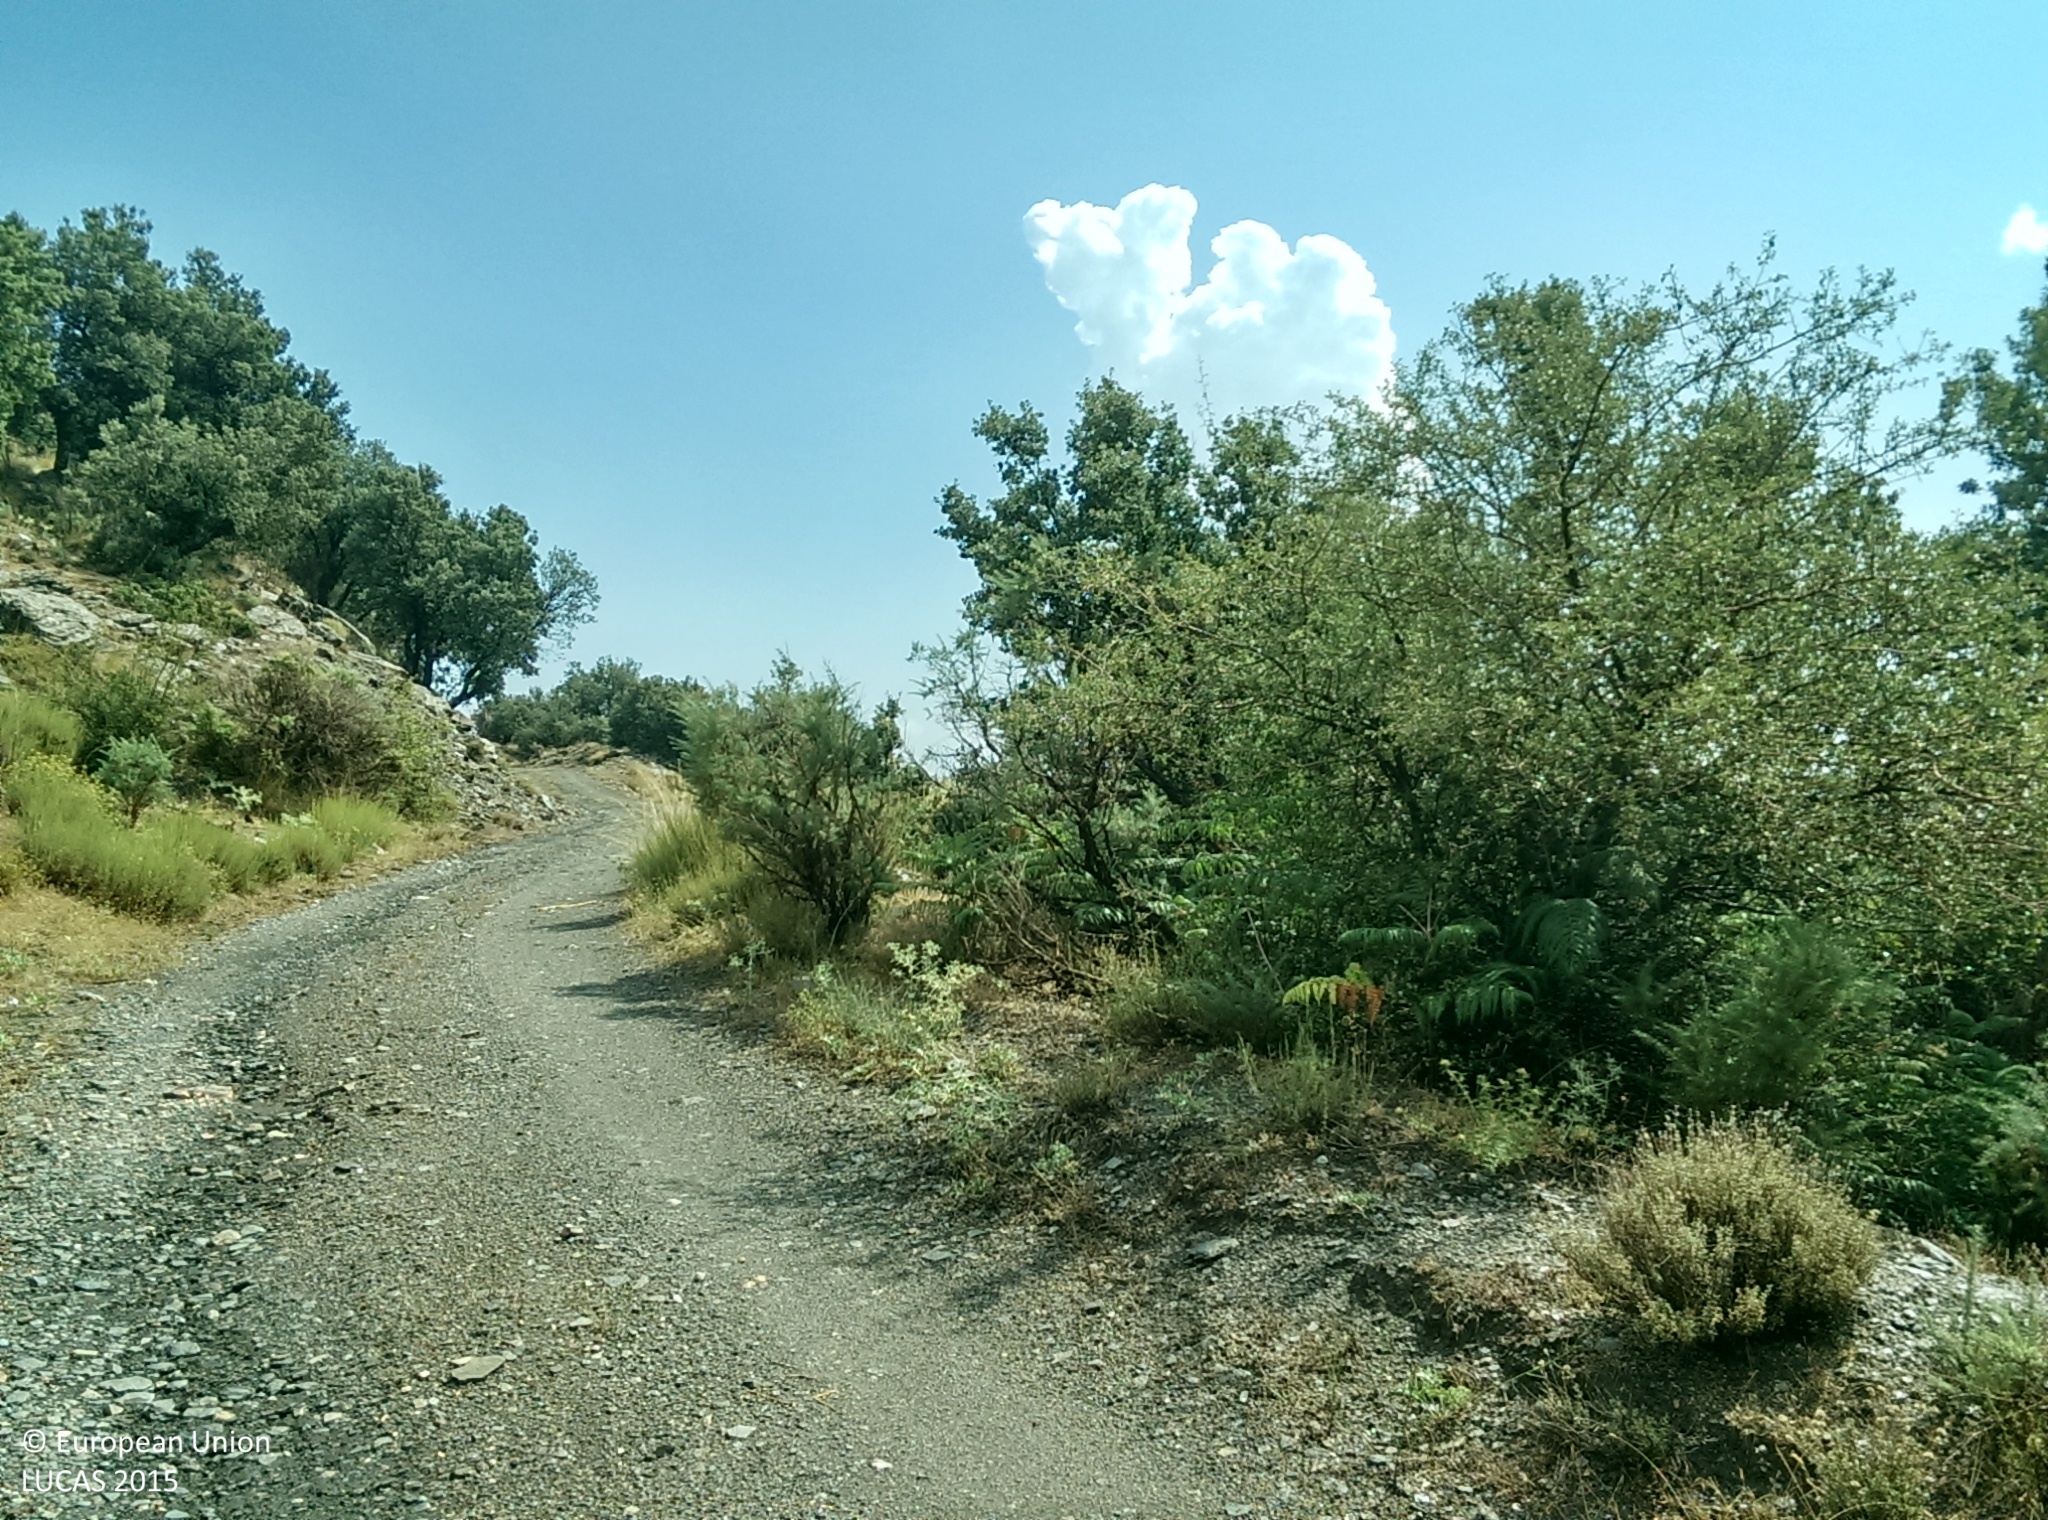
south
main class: Woodland
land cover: Broadleaved woodland
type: broadleaved evergreen forest
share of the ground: 50 - 75 %
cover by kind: broadleaved forest trees 65 %, shrubs 15 %, herbaceous plants 15 %, unconsolidated bare surface 5 %
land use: Forestry
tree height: > 5 m
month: July
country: ES
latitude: 37.0145
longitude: -3.1437
